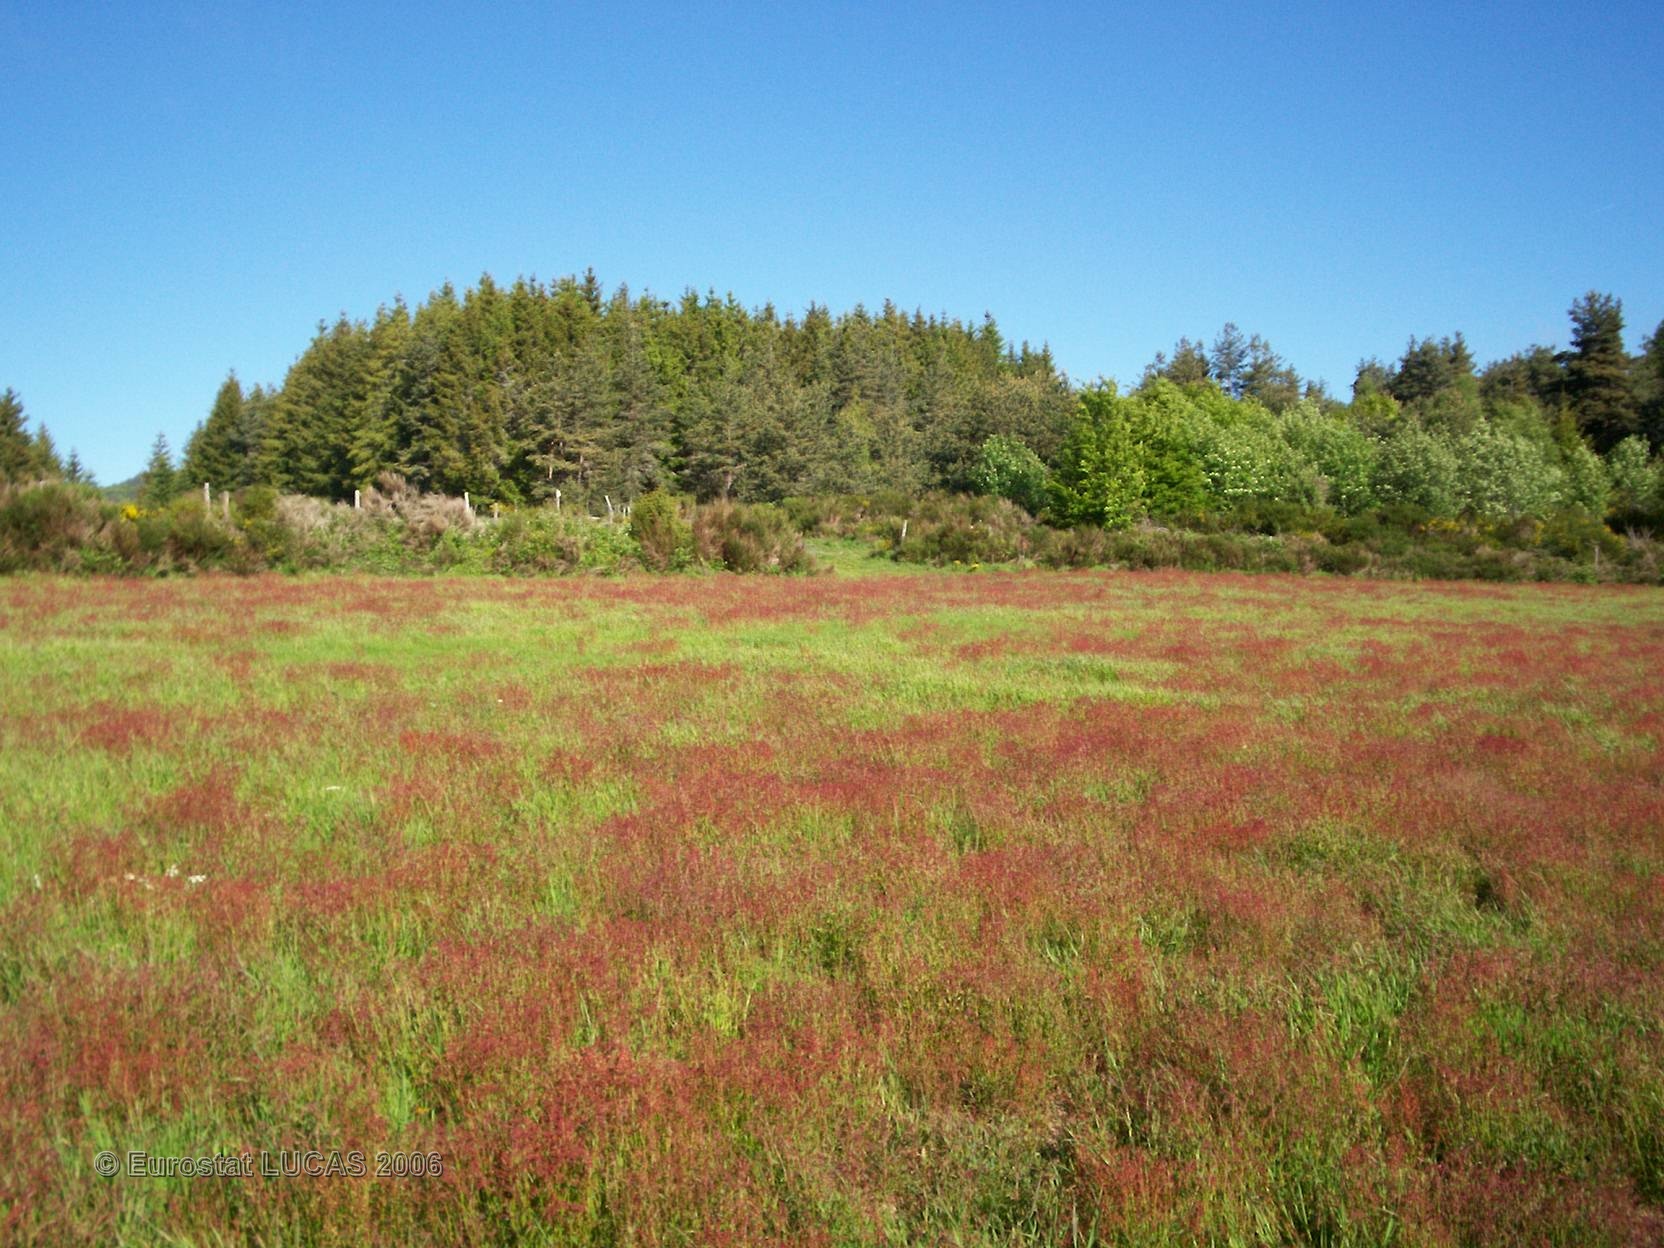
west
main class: Grassland
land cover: Grassland without tree/shrub cover
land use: Agriculture (excluding fallow land and kitchen gardens)
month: June
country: FR
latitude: 44.9526
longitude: 3.3741
